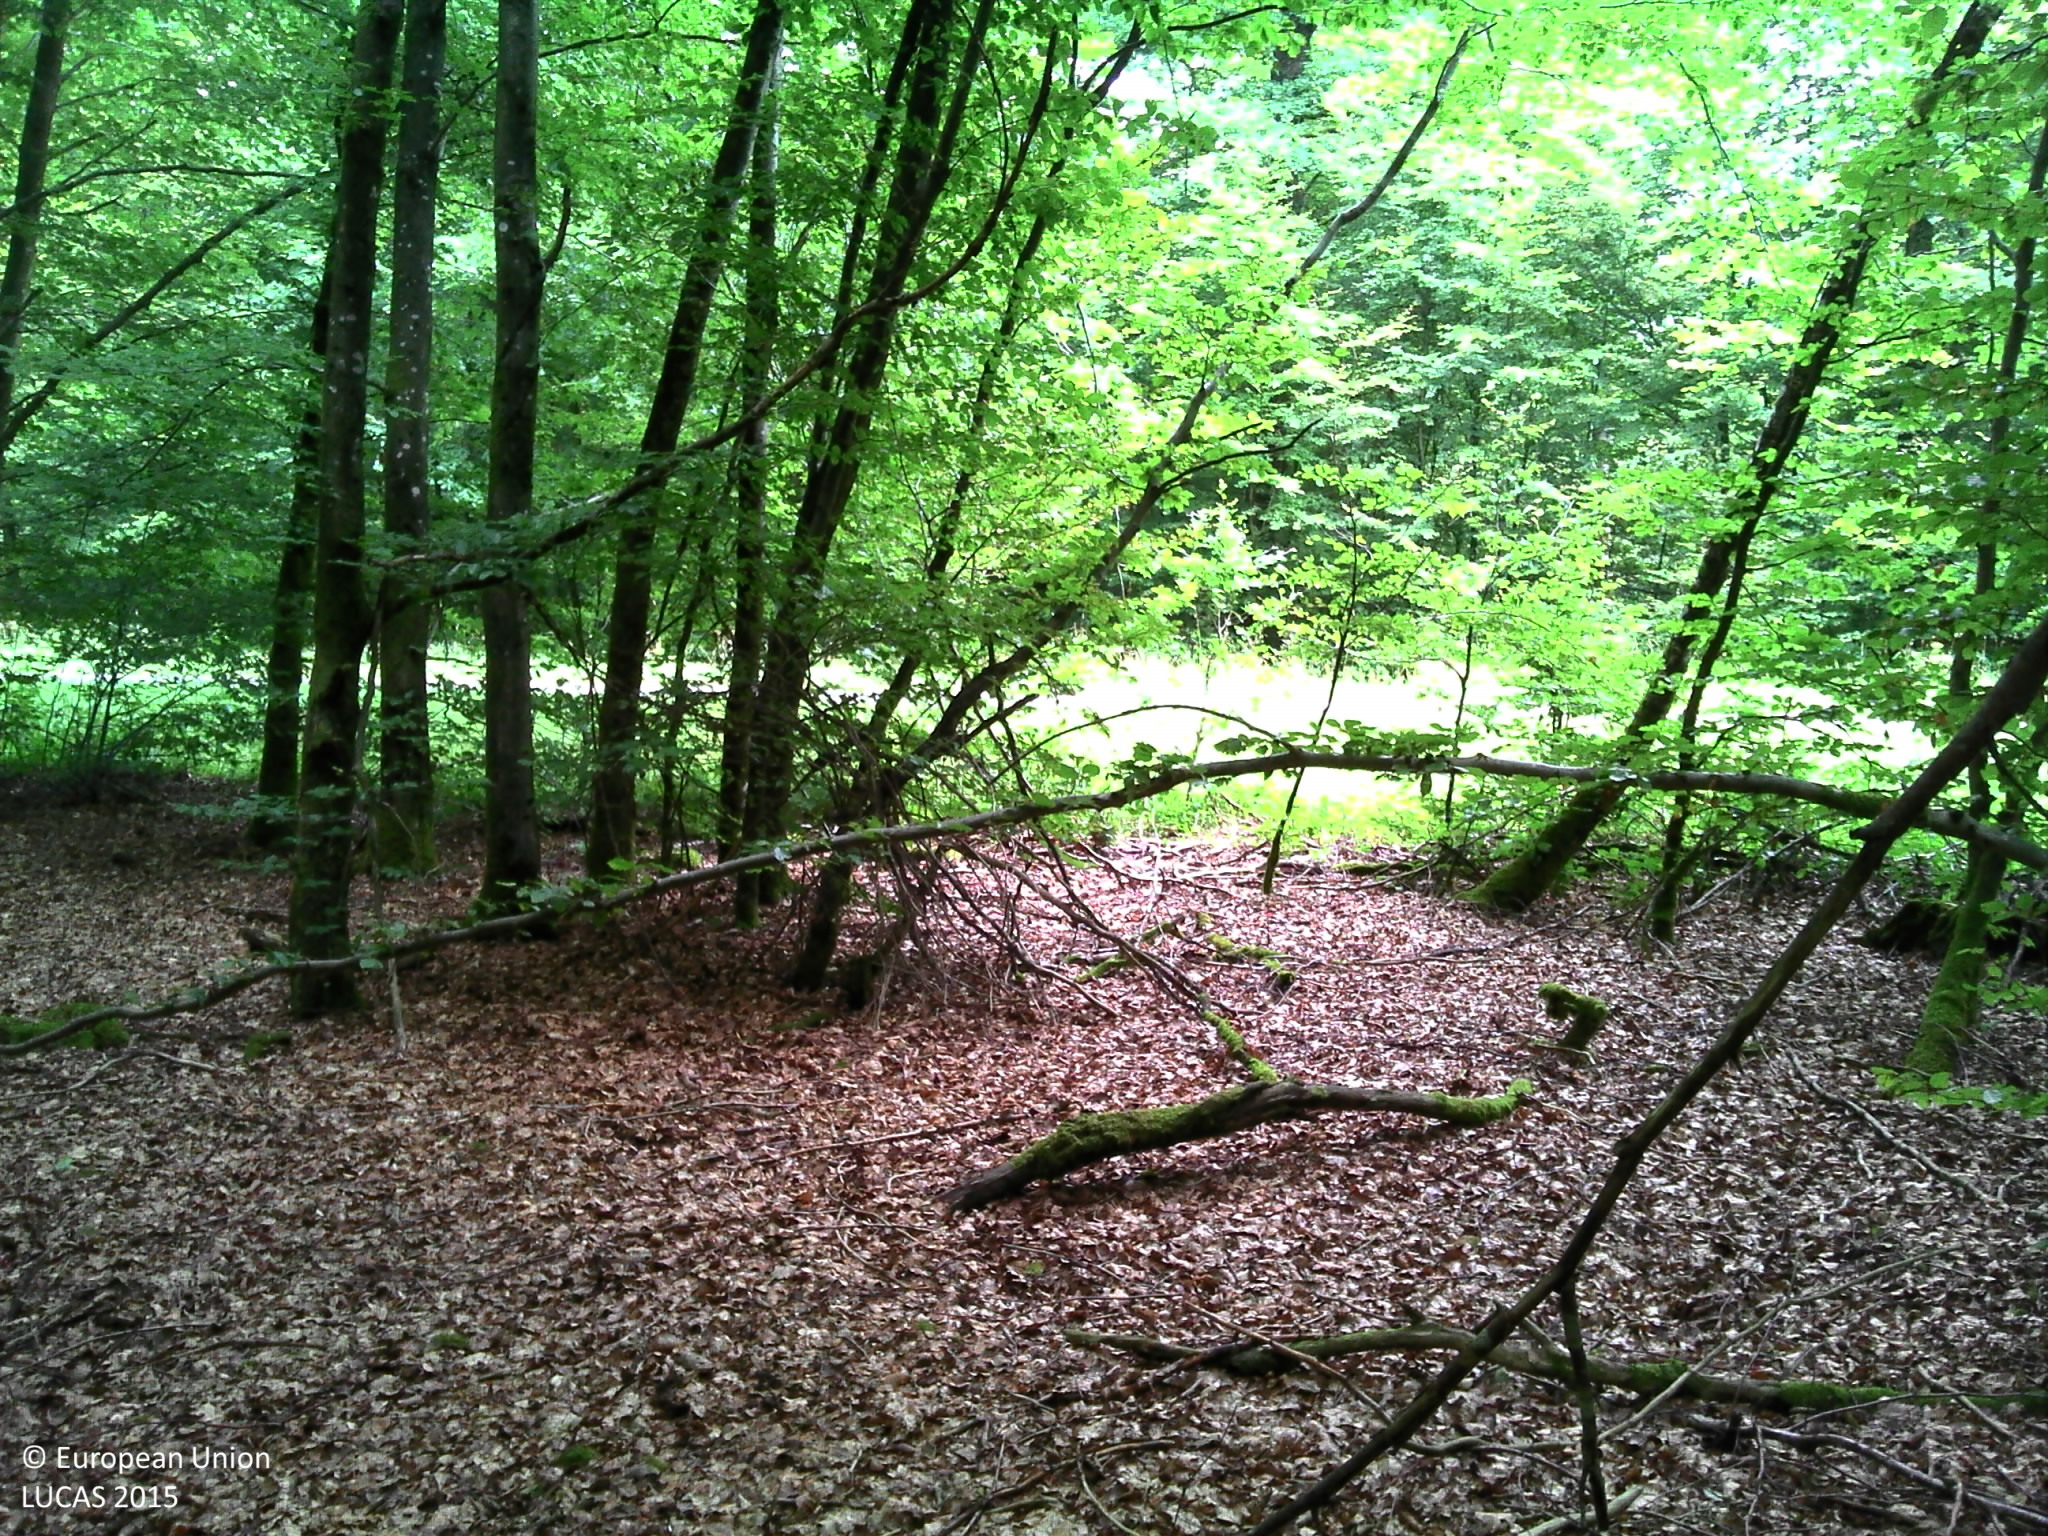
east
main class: Woodland
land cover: Broadleaved woodland
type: beech forest
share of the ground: > 75 %
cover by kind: broadleaved forest trees 100 %
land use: Forestry
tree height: > 5 m
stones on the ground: < 10 %
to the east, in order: Broadleaved woodland; Grass margins; Paved roads, cycling and walking lanes; Grass margins; Ditches and canals; Broadleaved woodland
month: July
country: BE
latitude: 49.7593
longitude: 5.6537
